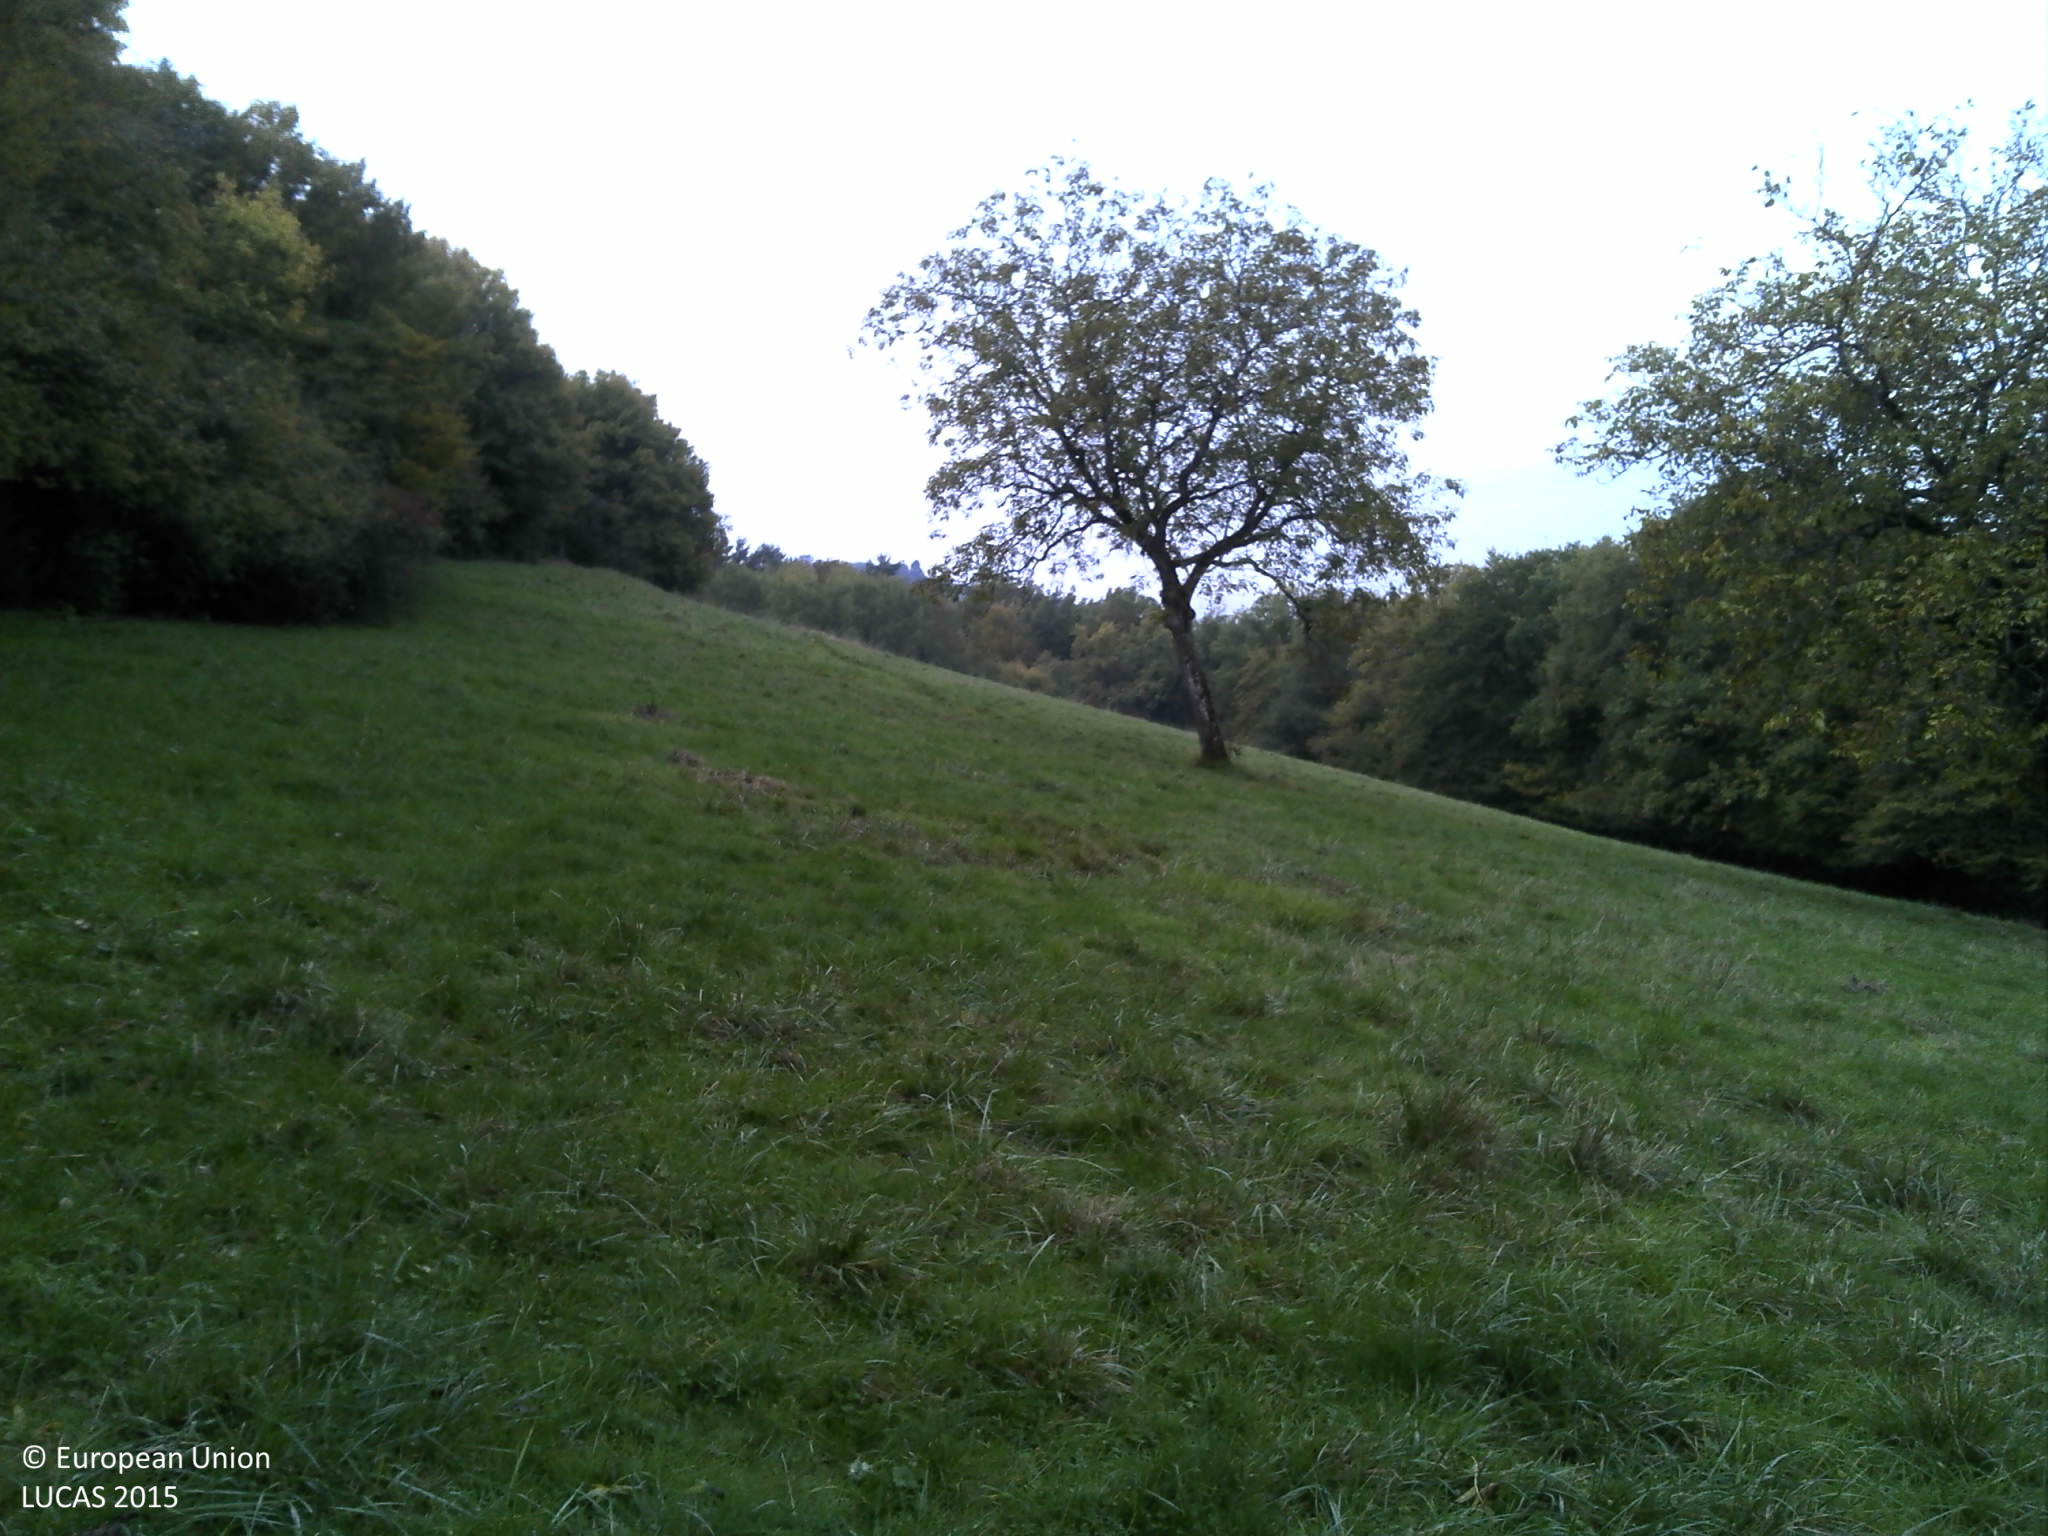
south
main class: Grassland
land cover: Grassland with sparse tree/shrub cover
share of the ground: > 75 %
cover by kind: herbaceous plants 95 %, broadleaved forest trees 5 %
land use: Agriculture (excluding fallow land and kitchen gardens)
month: October
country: FR
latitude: 46.1050
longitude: 5.3330
